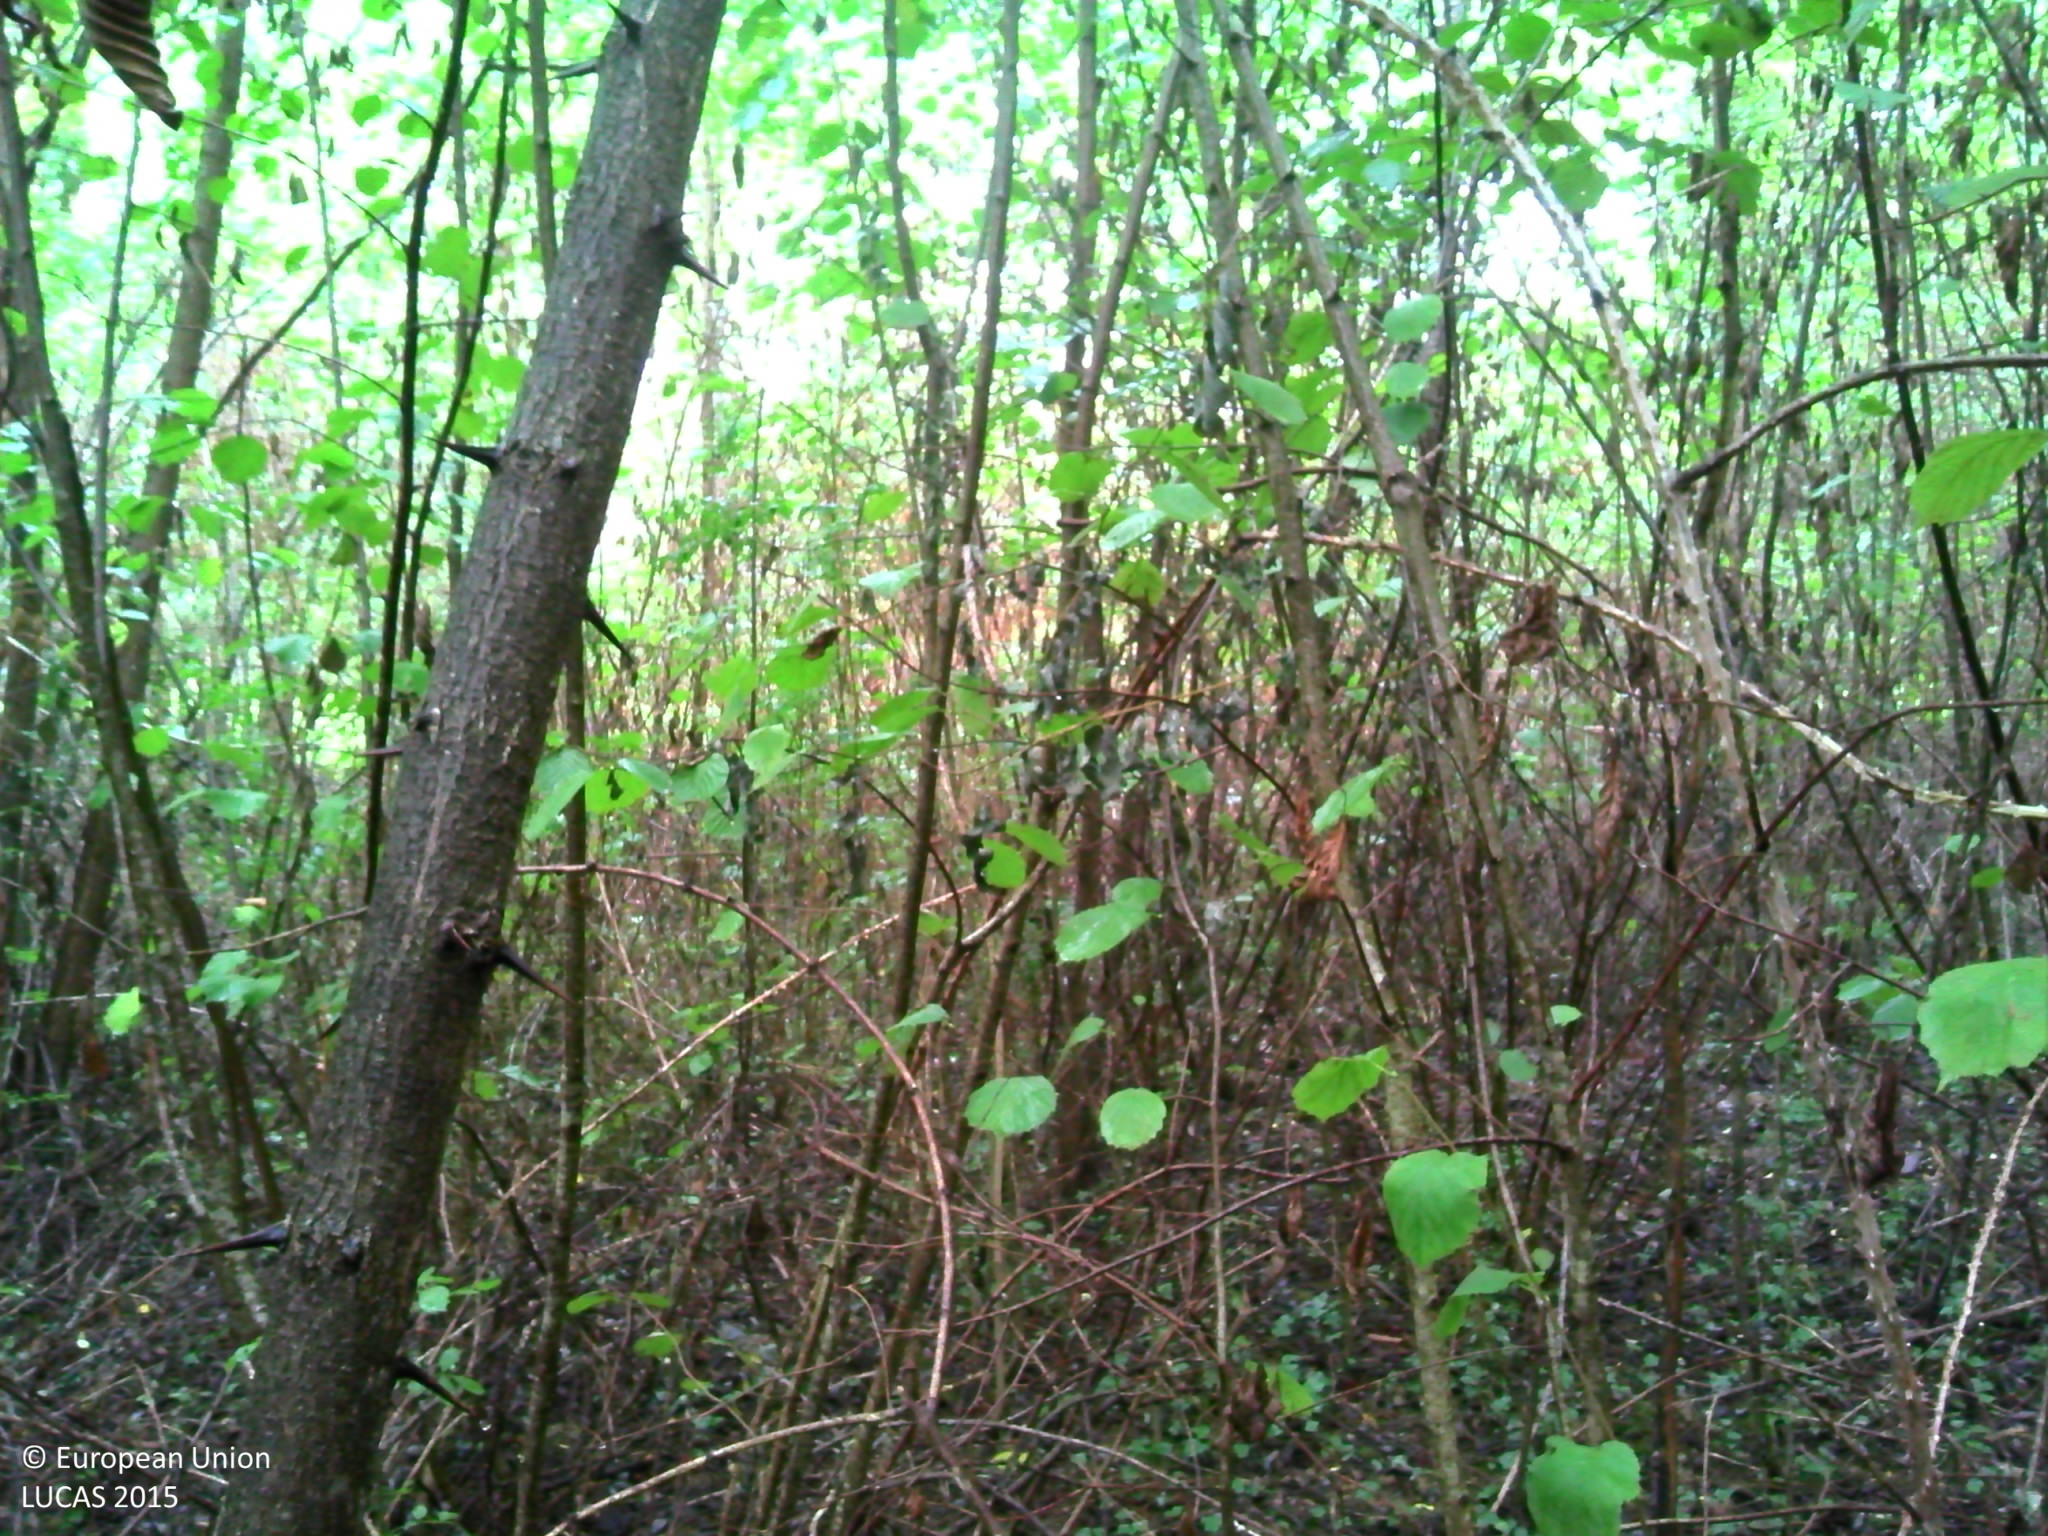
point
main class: Woodland
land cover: Broadleaved woodland
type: mesophytic deciduous forest
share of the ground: > 75 %
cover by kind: broadleaved forest trees 95 %, herbaceous plants 5 %
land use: Semi-natural and natural areas not in use
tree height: > 5 m
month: October
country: FR
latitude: 46.4396
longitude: 5.1475
